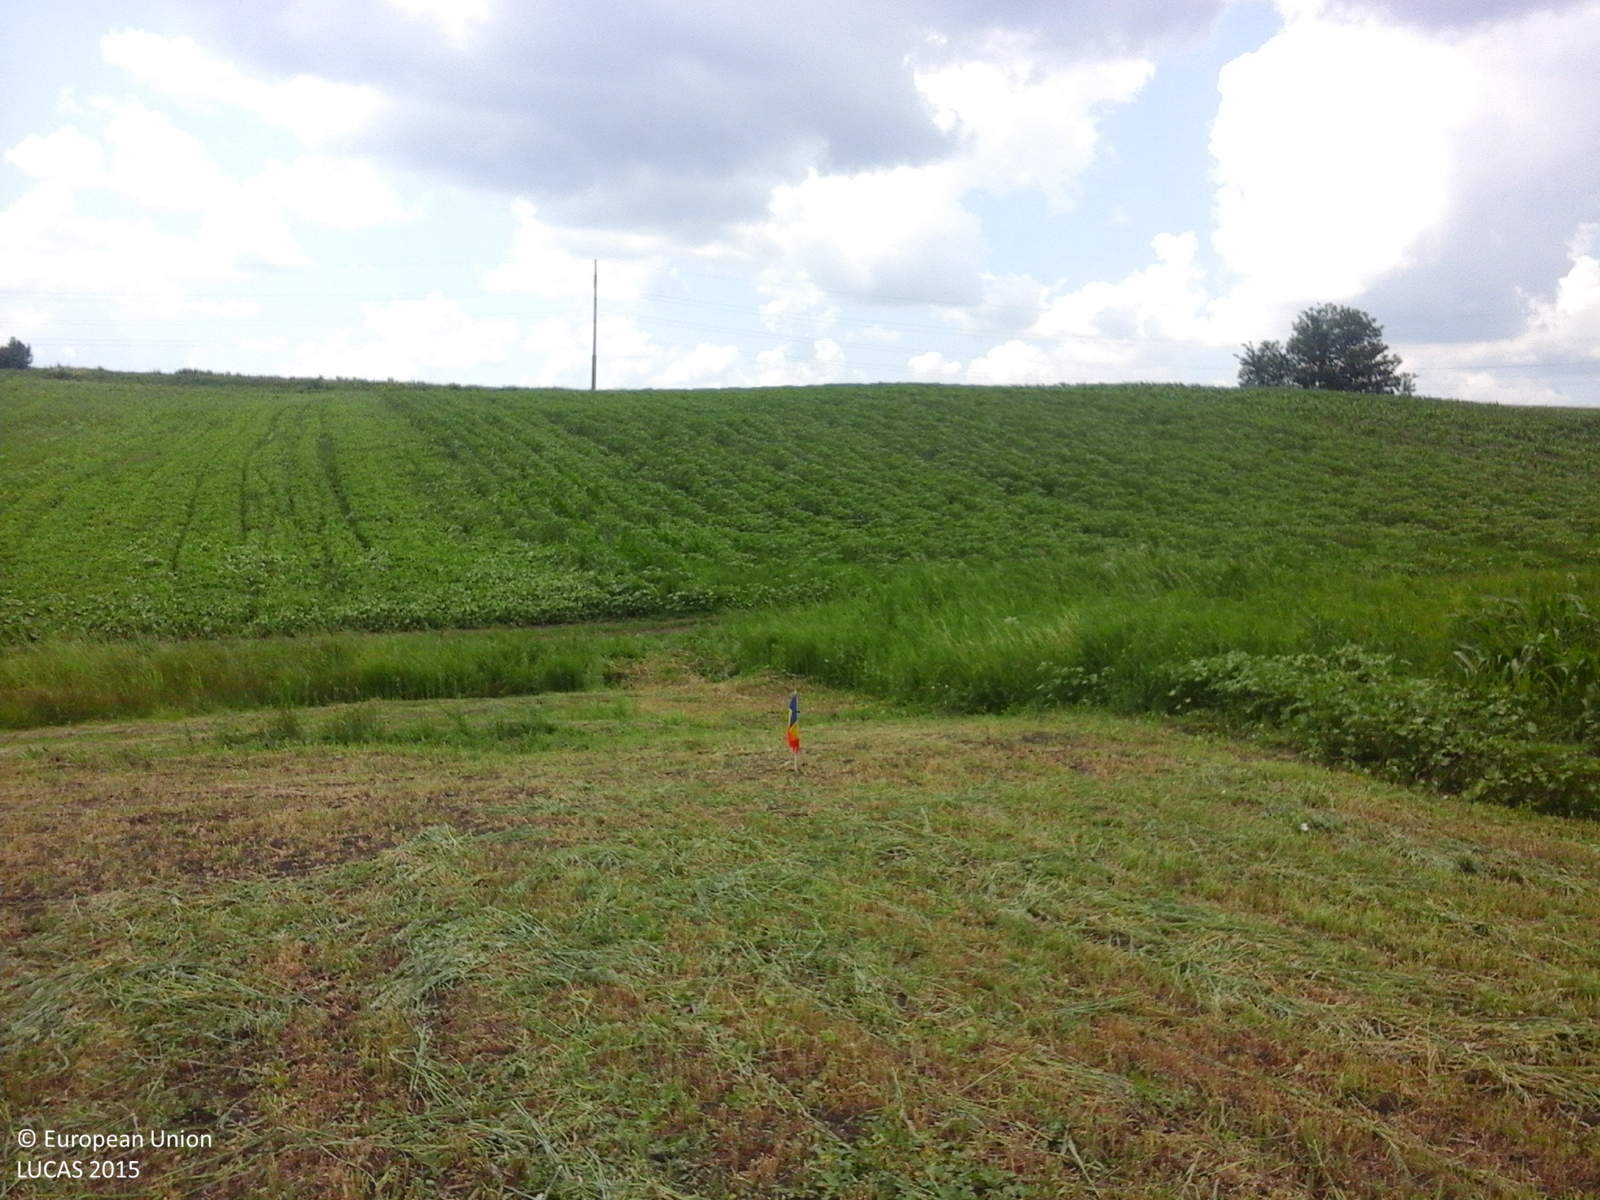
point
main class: Cropland
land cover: Oats
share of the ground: < 10 %
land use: Agriculture (excluding fallow land and kitchen gardens)
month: June
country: RO
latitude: 48.1410
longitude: 26.6404
